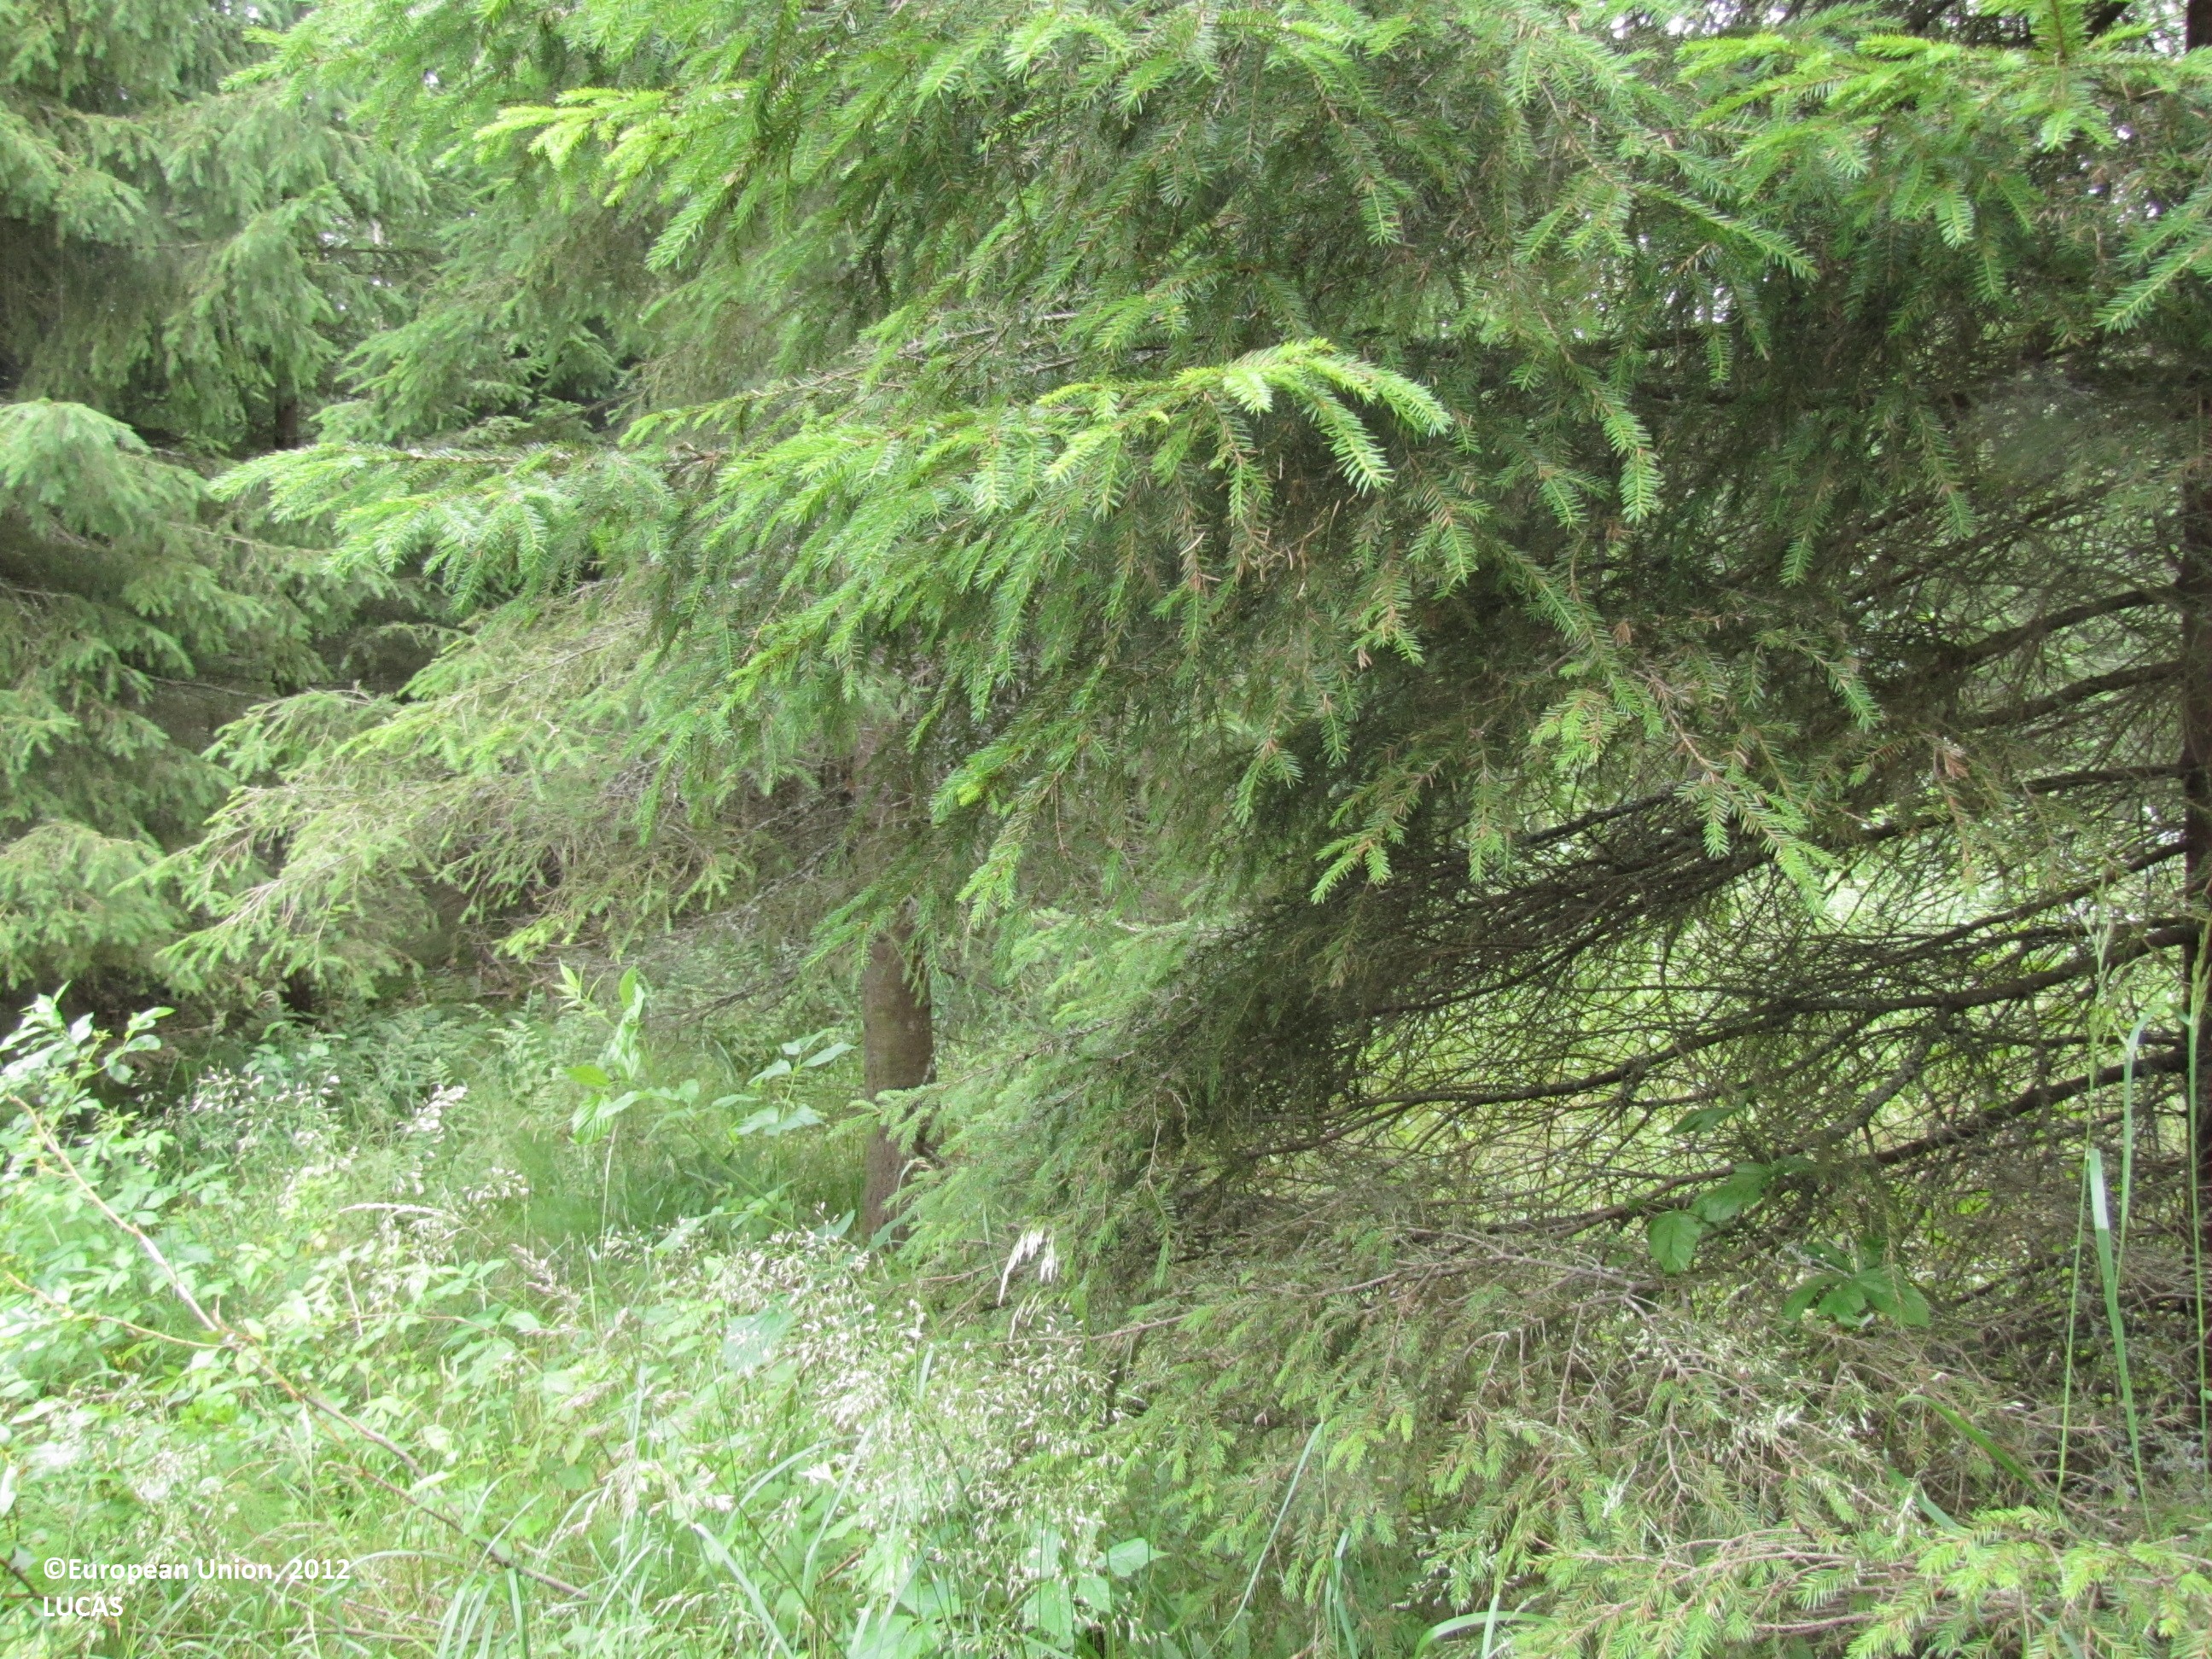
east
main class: Woodland
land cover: Spruce dominated coniferous woodland
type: boreal forest
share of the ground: > 75 %
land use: Forestry
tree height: > 5 m
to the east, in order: Spruce dominated coniferous woodland; Ditches and canals; Pine dominated mixed woodland; Ditches and canals; Pine dominated mixed woodland; Ditches and canals; Pine dominated mixed woodland; Ditches and canals; Shrubland with sparse tree cover; Other bare soil; Inland water bodies; Other bare soil; Ditches and canals; Pine dominated coniferous woodland; Ditches and canals; Other bare soil; Ditches and canals; Peatbogs; Other bare soil
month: July
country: FI
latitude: 62.6876
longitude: 23.4106
